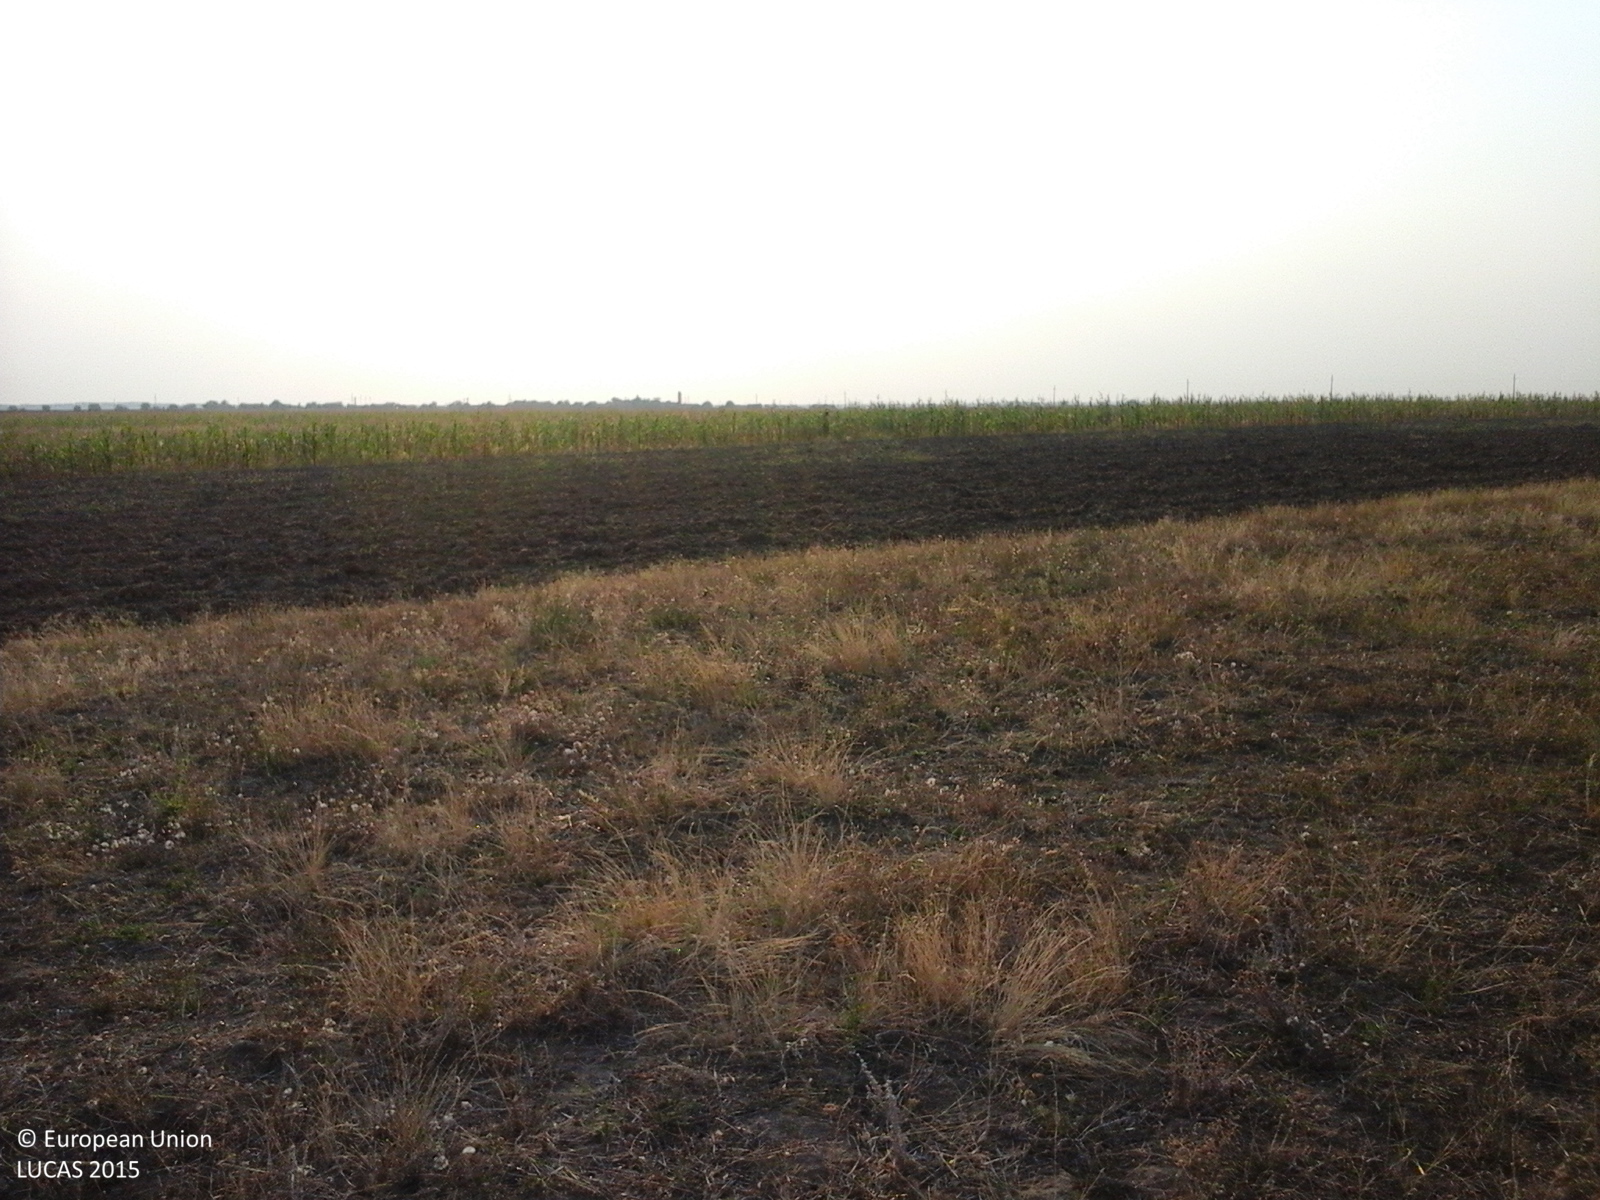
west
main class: Grassland
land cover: Spontaneously vegetated surfaces
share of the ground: > 75 %
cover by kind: herbaceous plants 100 %
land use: Fallow land
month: August
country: RO
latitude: 44.2819
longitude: 22.9620
